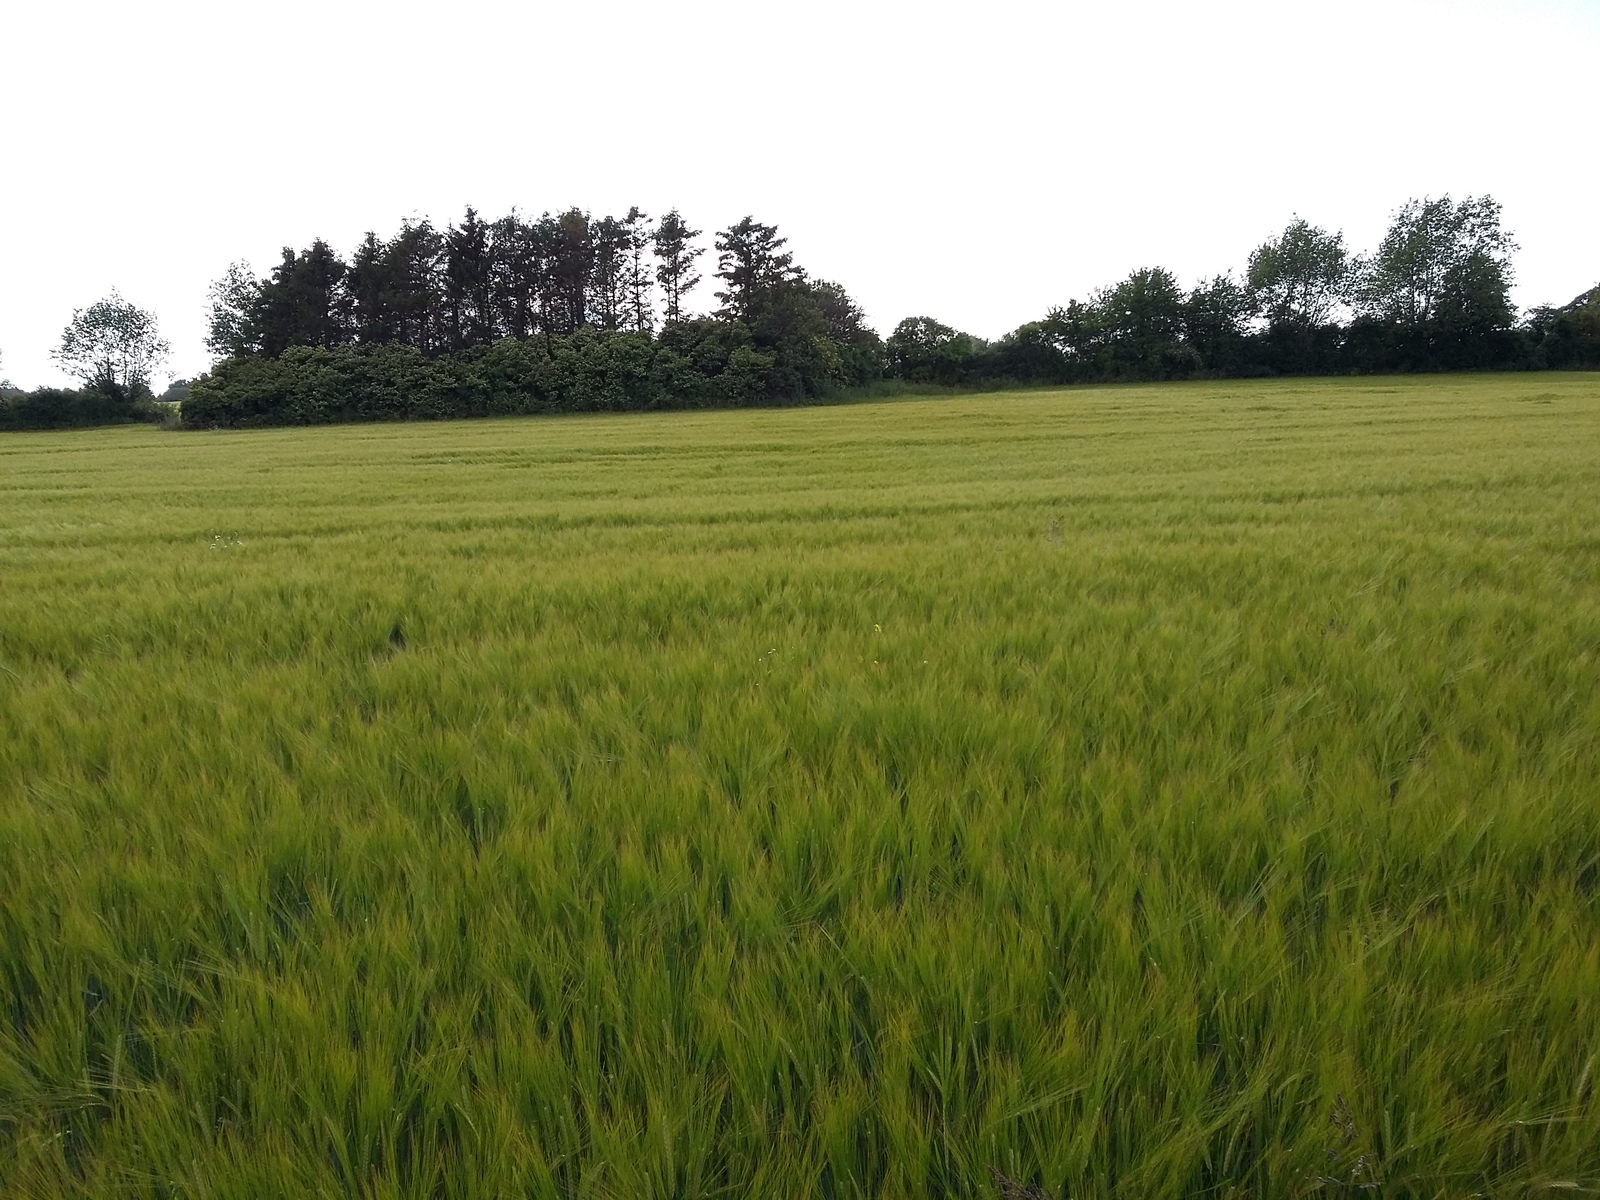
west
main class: Cropland
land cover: Barley
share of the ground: > 75 %
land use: Agriculture (excluding fallow land and kitchen gardens)
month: June
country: DK
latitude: 54.8056
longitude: 12.0057
